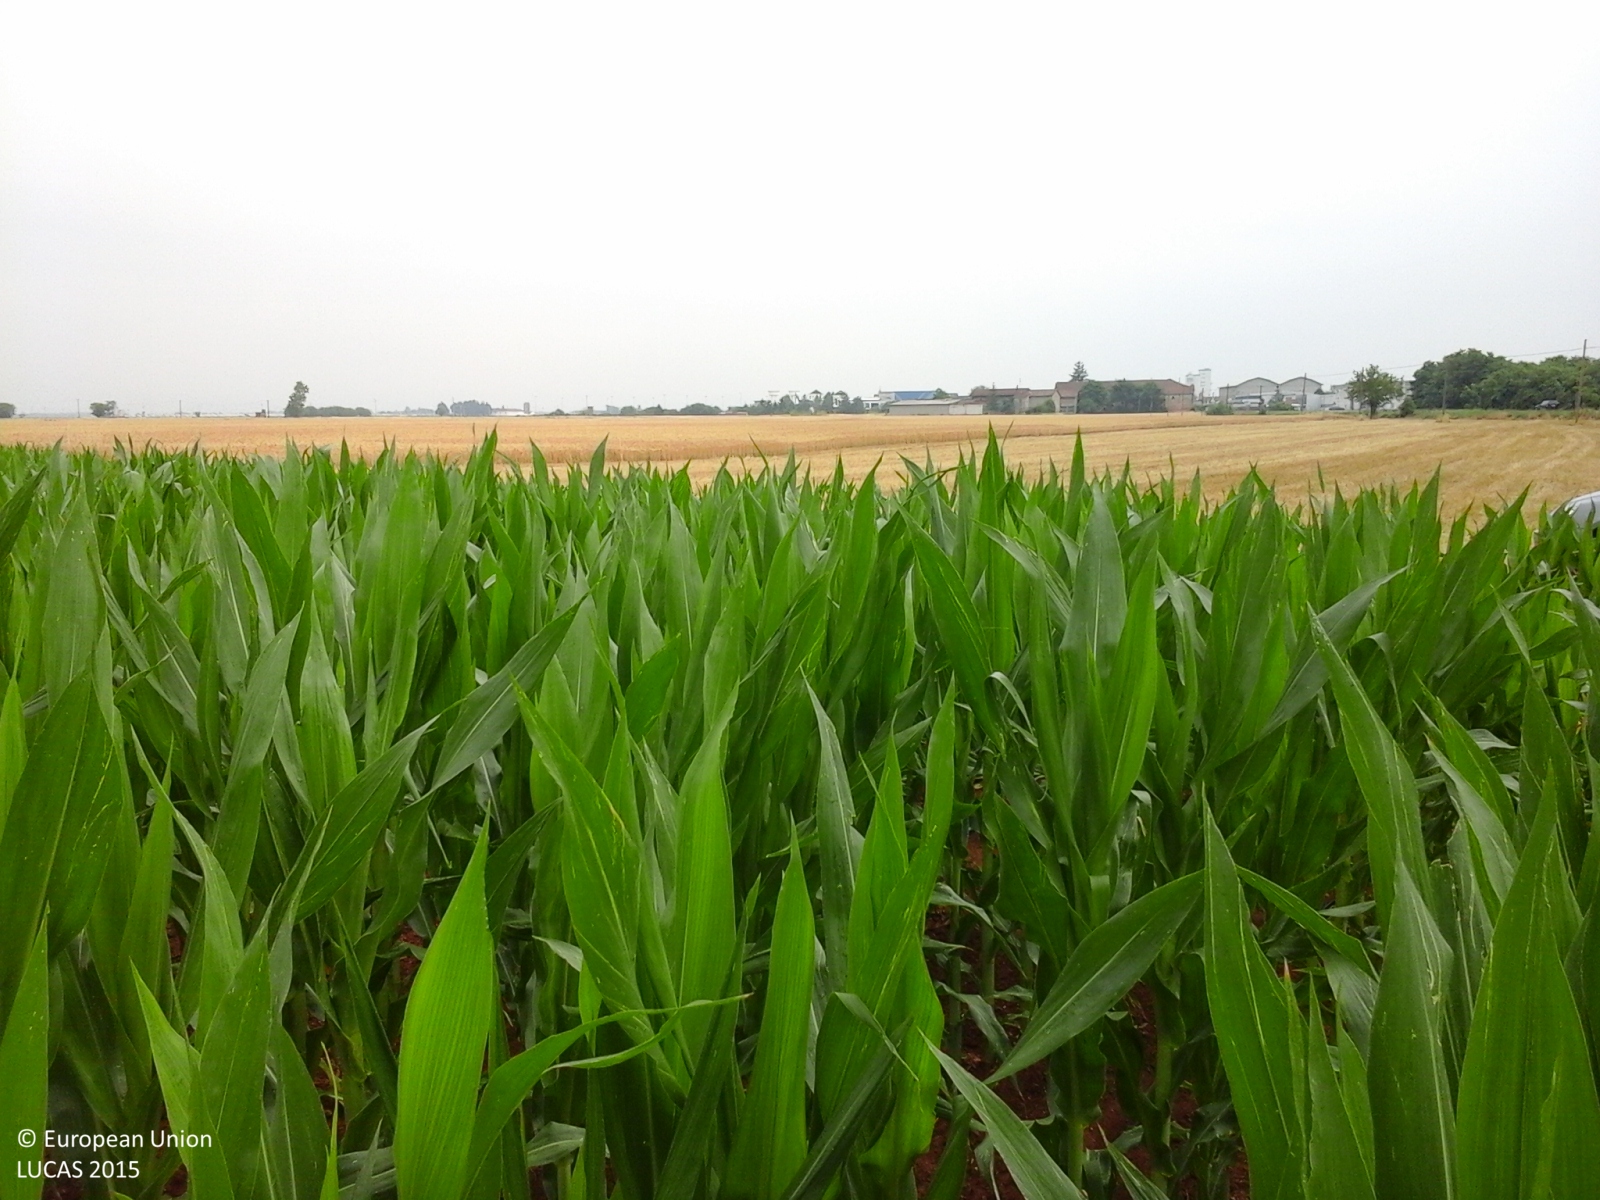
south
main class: Cropland
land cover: Maize
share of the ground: > 75 %
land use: Agriculture (excluding fallow land and kitchen gardens)
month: June
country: IT
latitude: 44.8477
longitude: 8.7247
